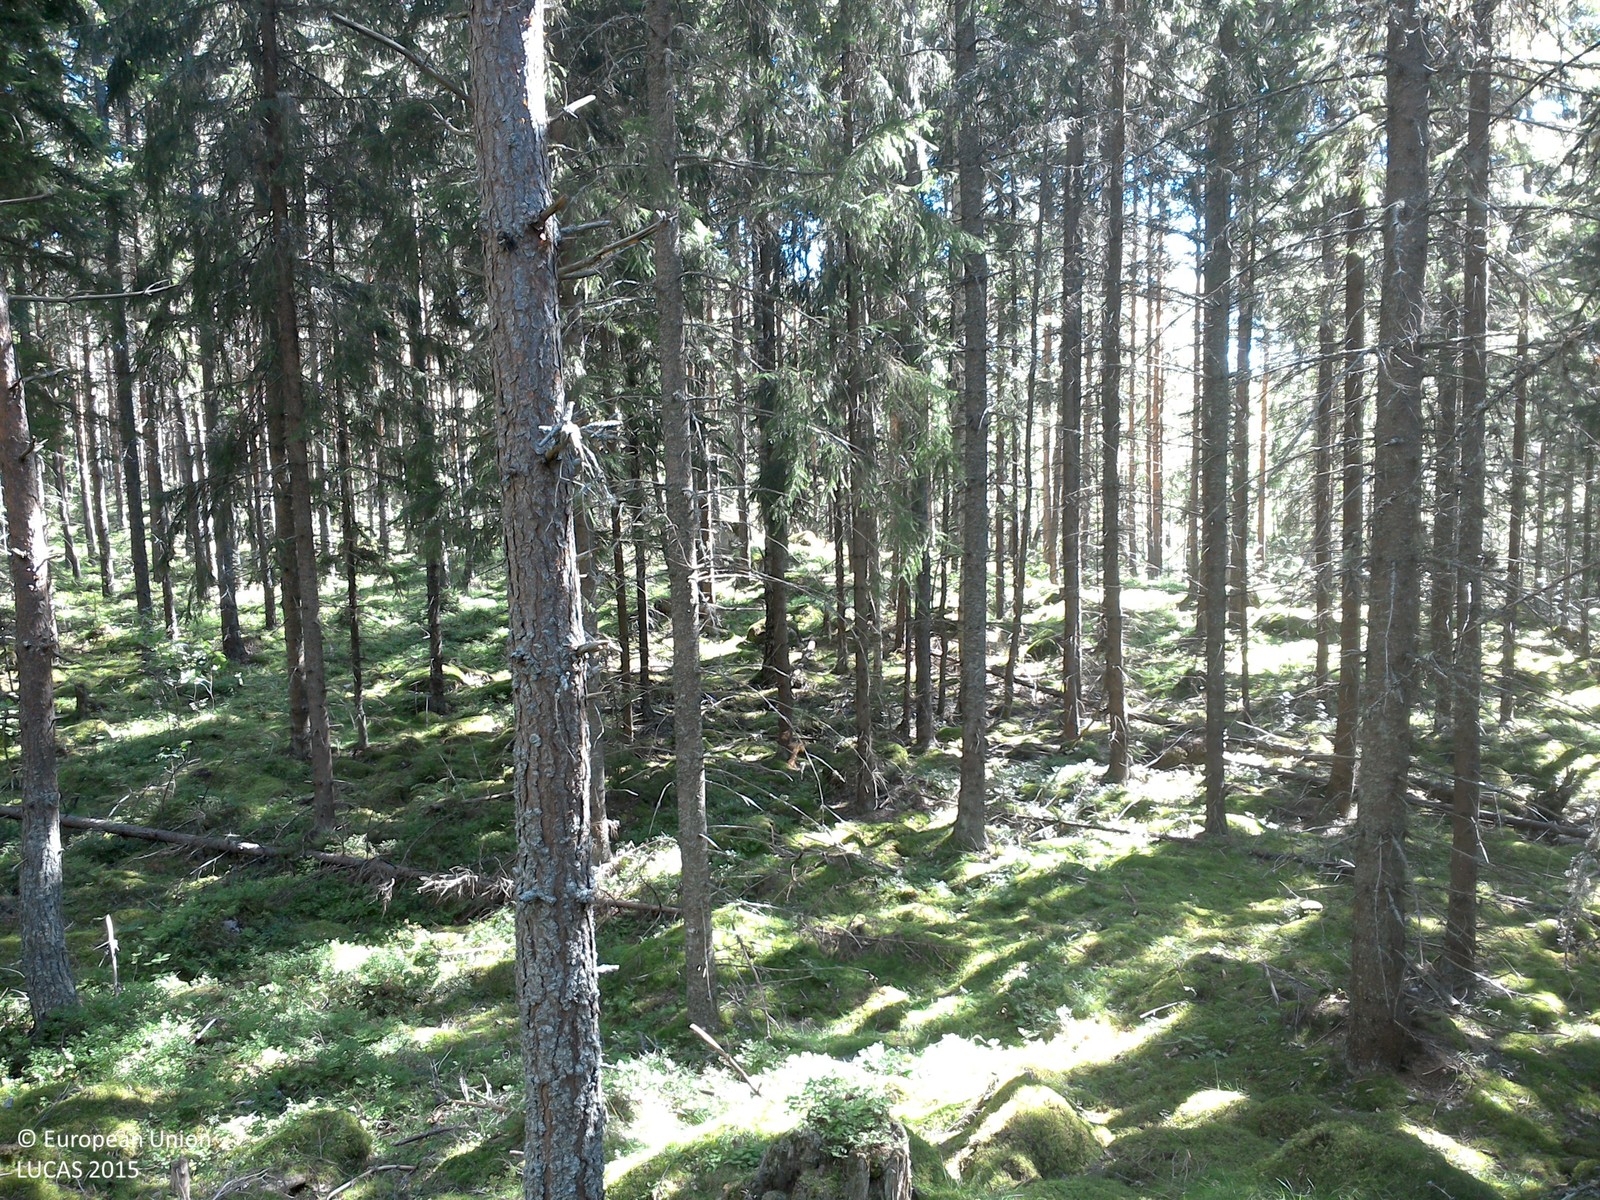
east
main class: Woodland
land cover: Pine dominated coniferous woodland
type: boreal forest
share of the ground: 25 - 50 %
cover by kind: coniferous forest trees 50 %, lichens and mosses 40 %, herbaceous plants 10 %
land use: Forestry
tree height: > 5 m
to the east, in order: Pine dominated coniferous woodland; Spruce dominated coniferous woodland; Pine dominated coniferous woodland; Spruce dominated coniferous woodland; Spruce dominated mixed woodland; Pine dominated coniferous woodland
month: August
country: SE
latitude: 58.2148
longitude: 15.0498
